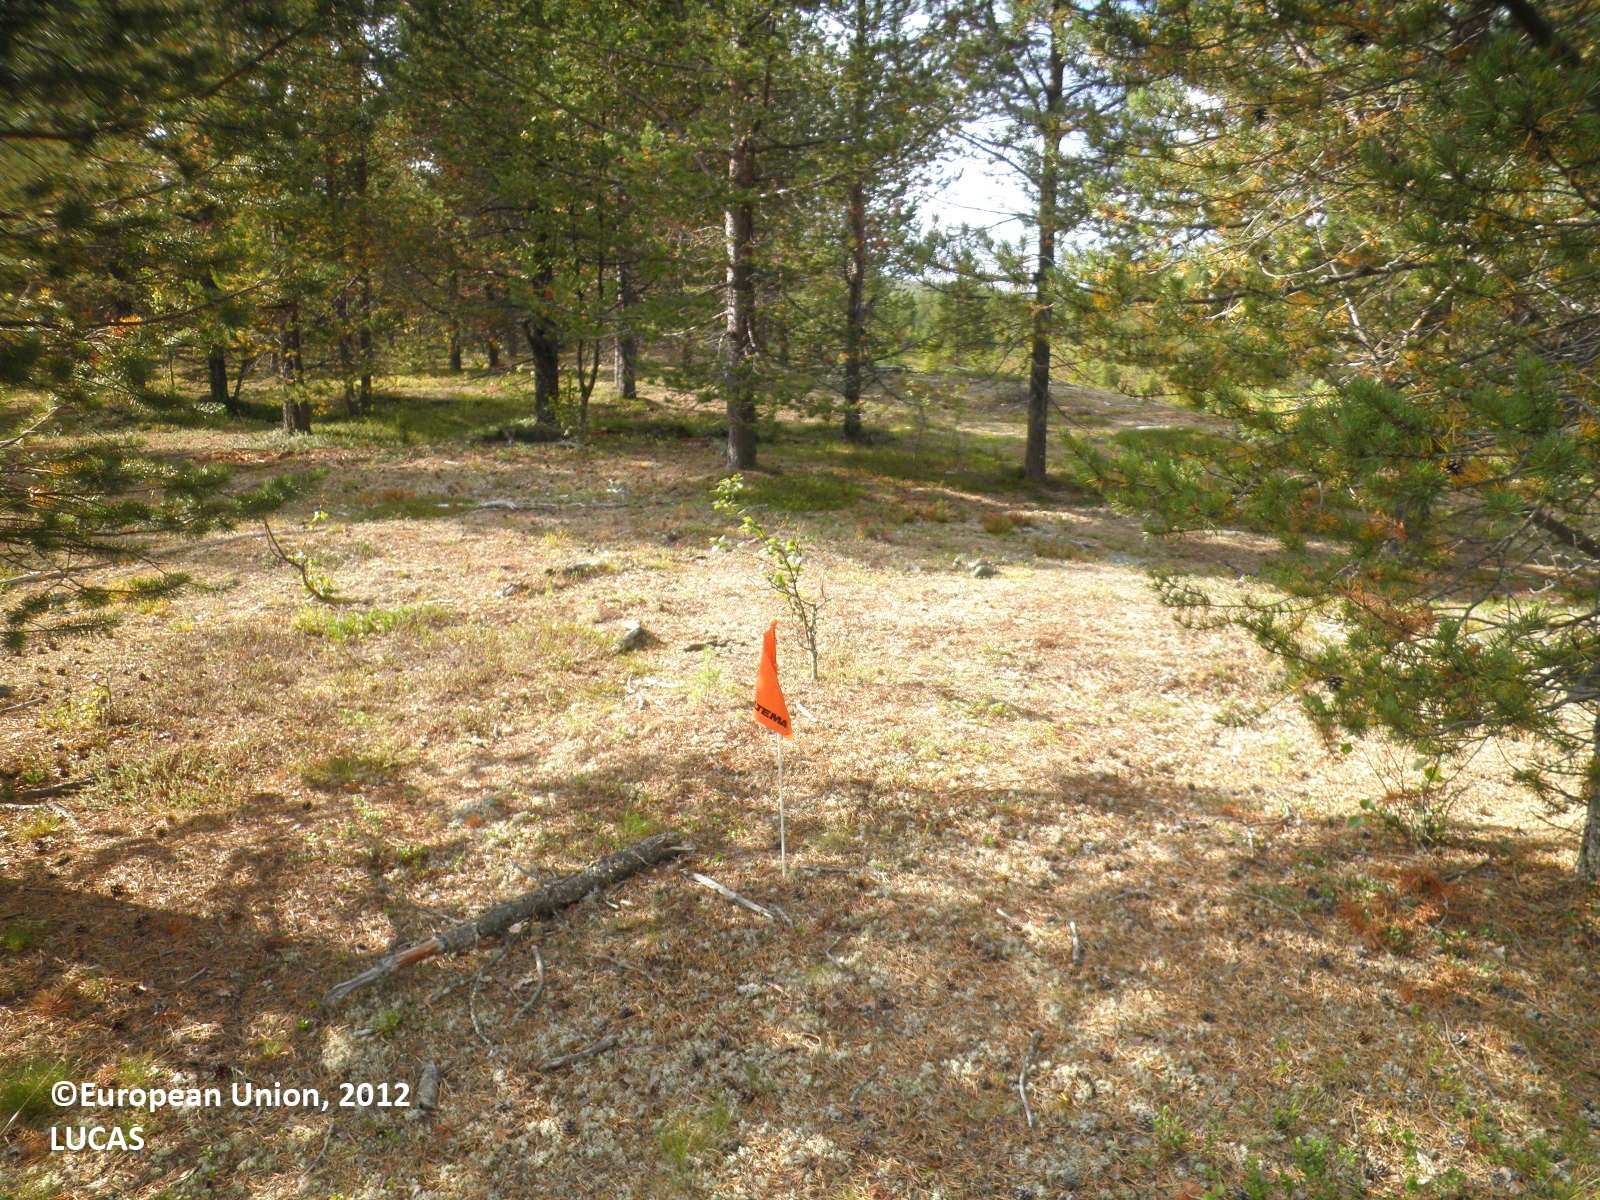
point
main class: Woodland
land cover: Pine dominated coniferous woodland
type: boreal forest
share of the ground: 25 - 50 %
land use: Forestry
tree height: > 5 m
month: August
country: FI
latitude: 67.5951
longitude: 29.9031
